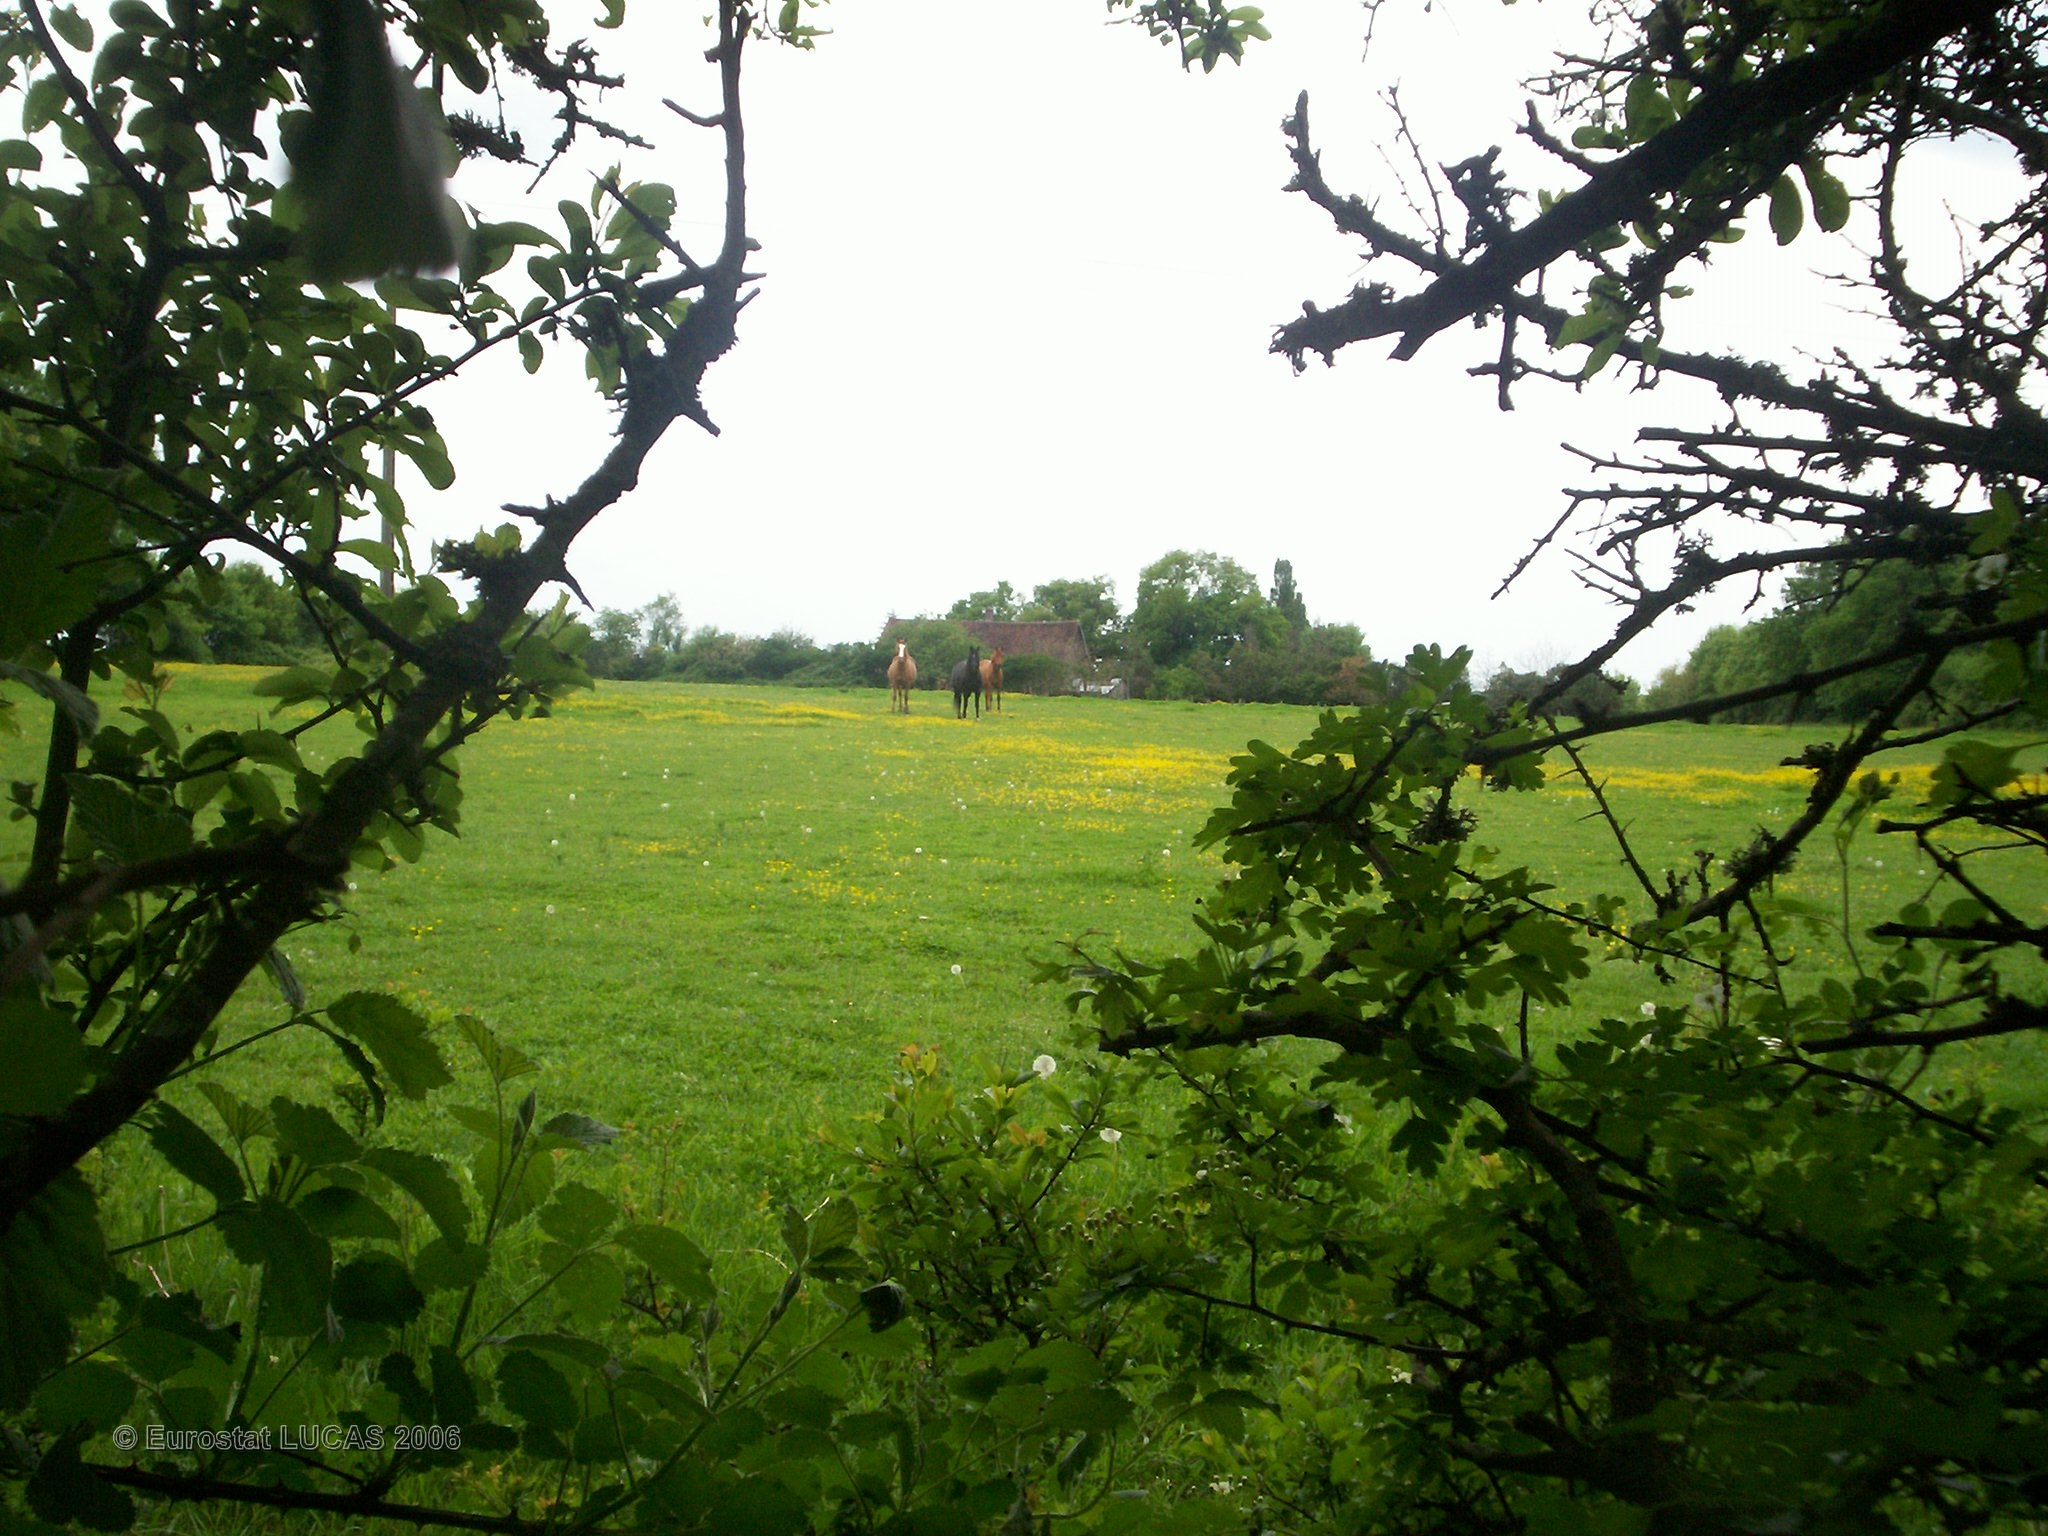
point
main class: Grassland
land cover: Grassland without tree/shrub cover
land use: Agriculture (excluding fallow land and kitchen gardens)
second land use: Sport
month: May
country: FR
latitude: 47.6921
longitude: 2.9720
